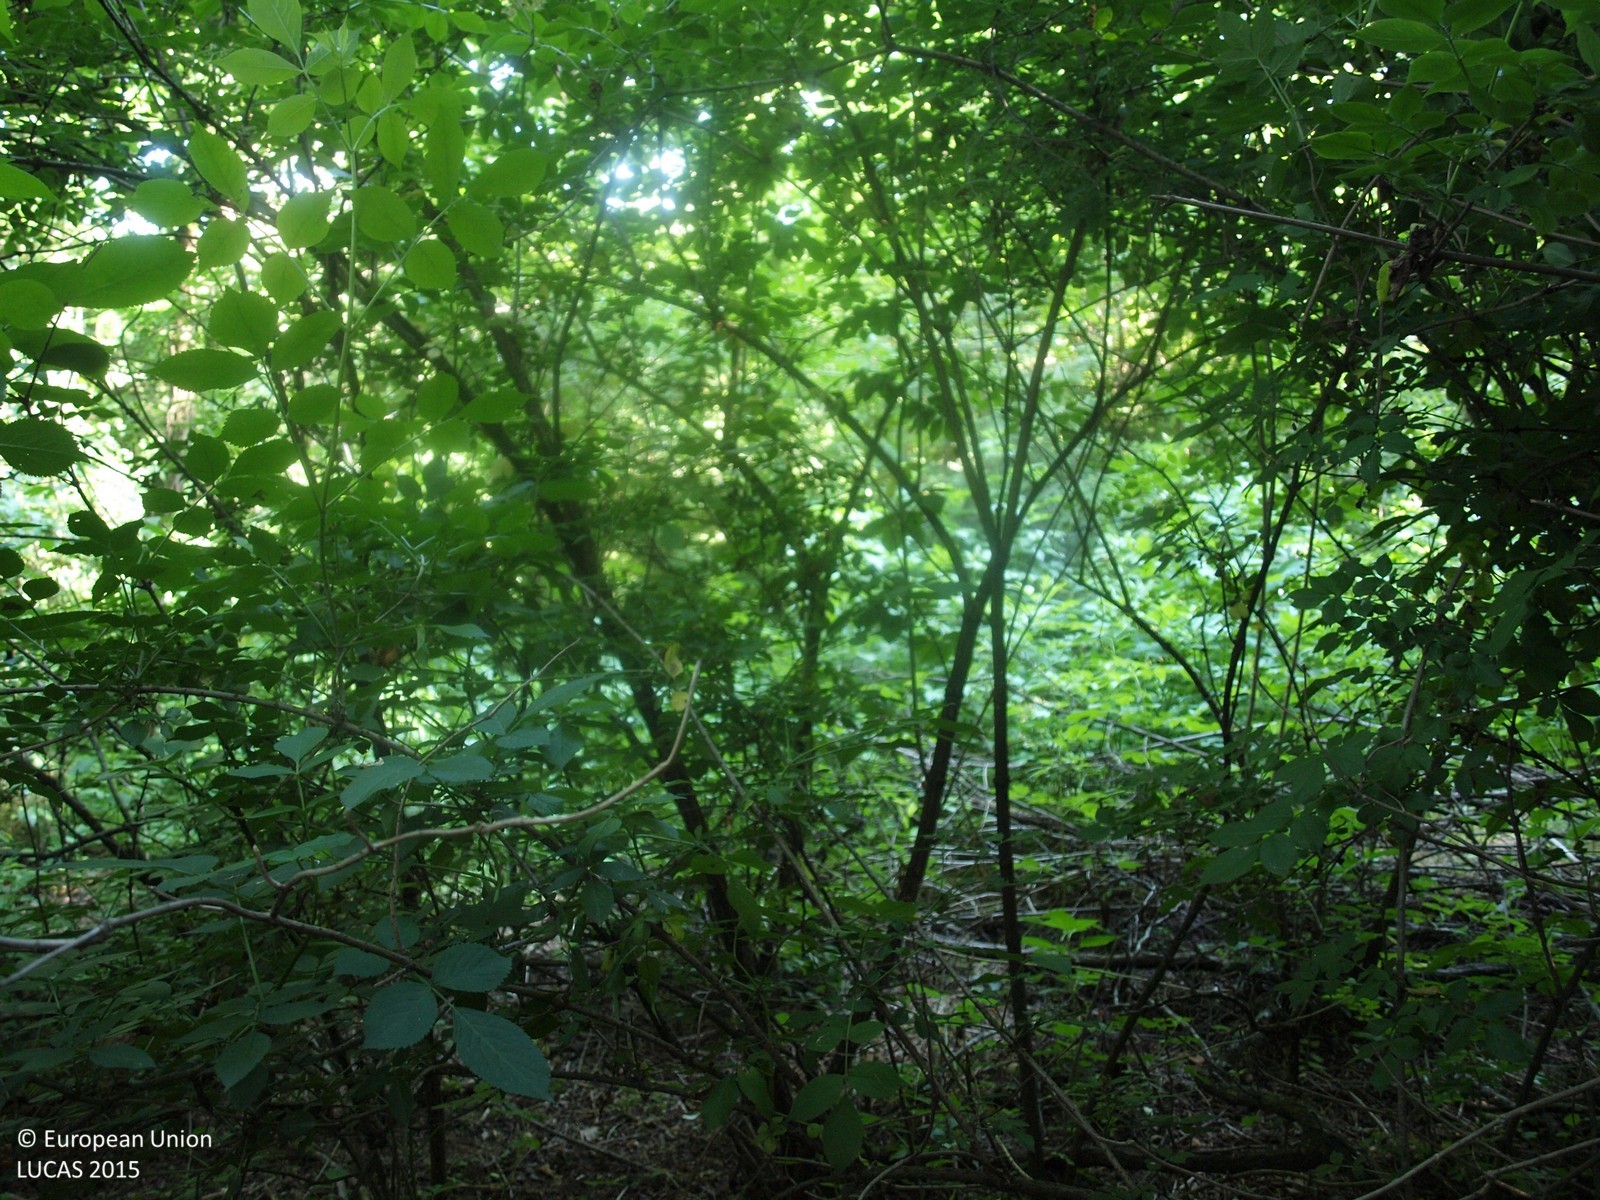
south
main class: Woodland
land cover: Broadleaved woodland
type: mesophytic deciduous forest
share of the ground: > 75 %
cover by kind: broadleaved forest trees 100 %
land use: Forestry
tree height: > 5 m
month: June
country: HR
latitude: 46.2997
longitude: 16.1664
